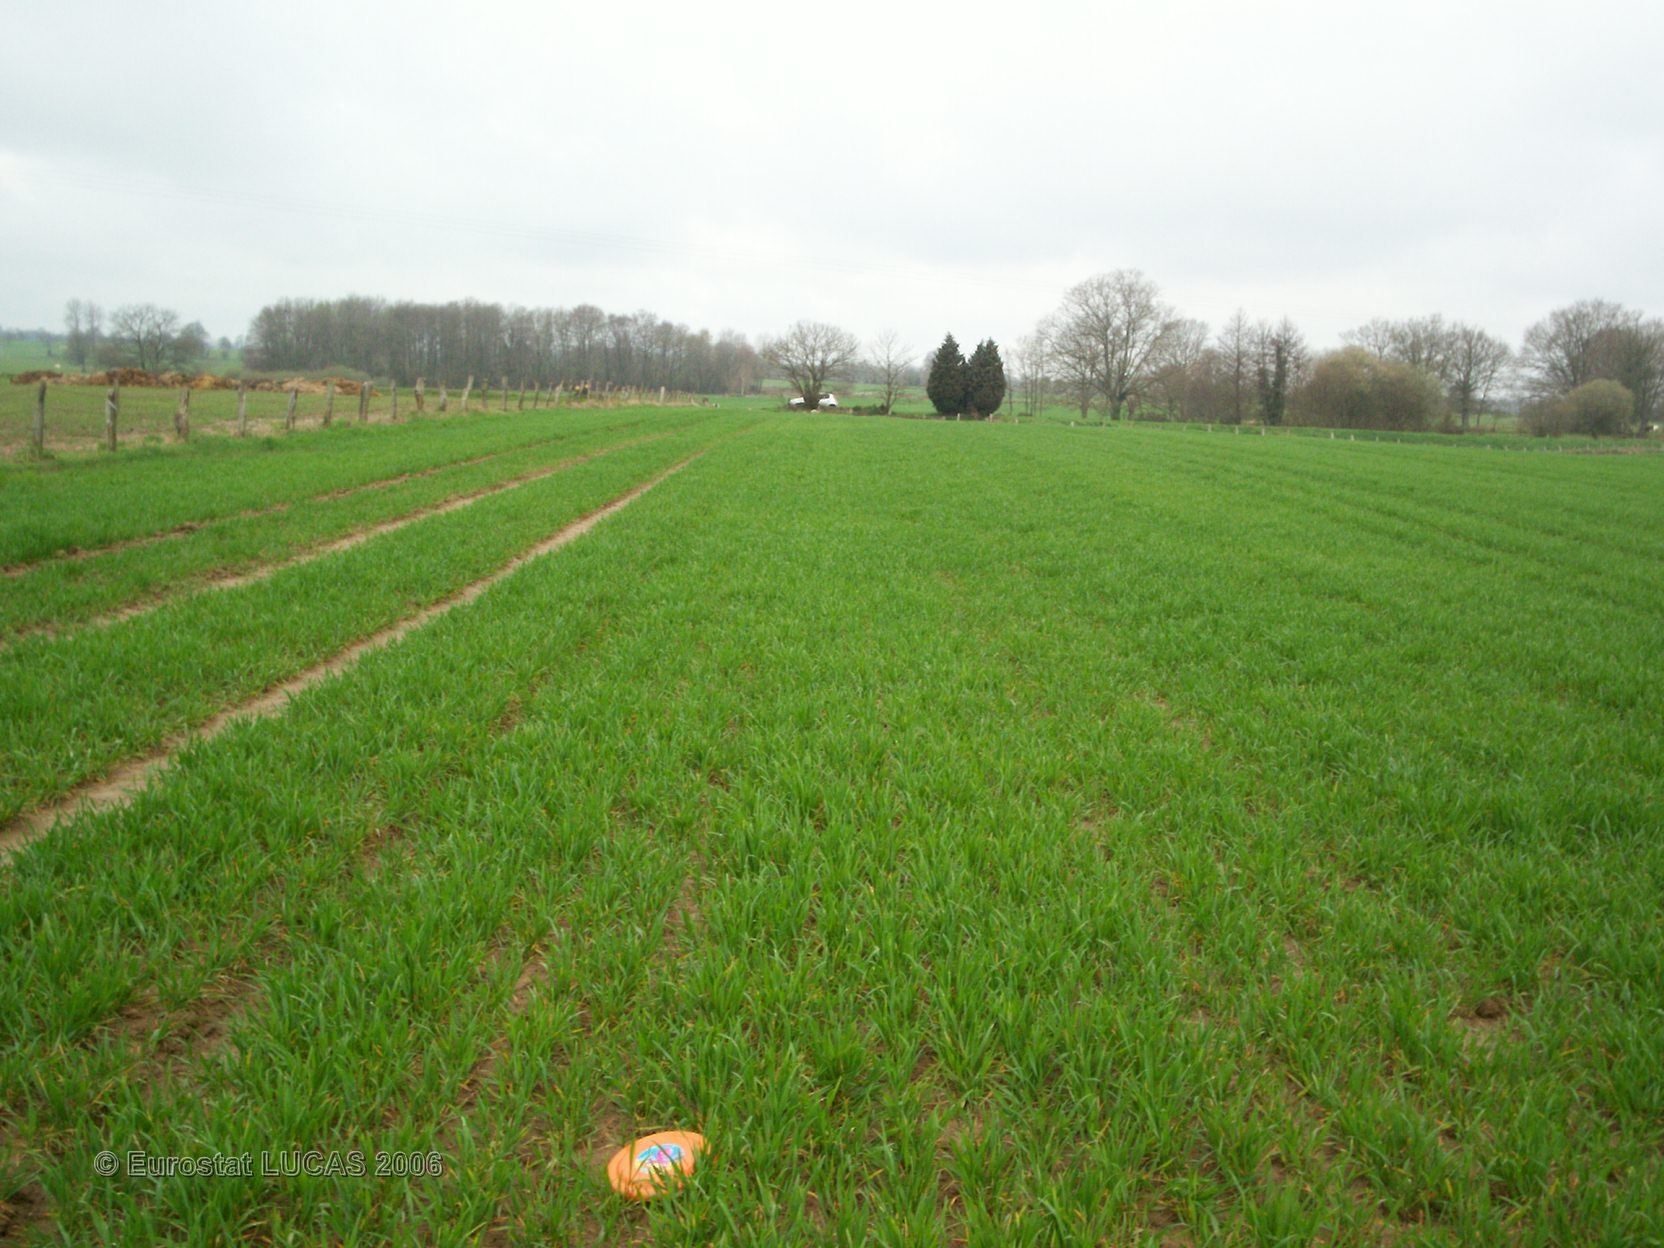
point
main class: Cropland
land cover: Common wheat
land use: Agriculture (excluding fallow land and kitchen gardens)
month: April
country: FR
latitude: 48.4450
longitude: -0.7035
